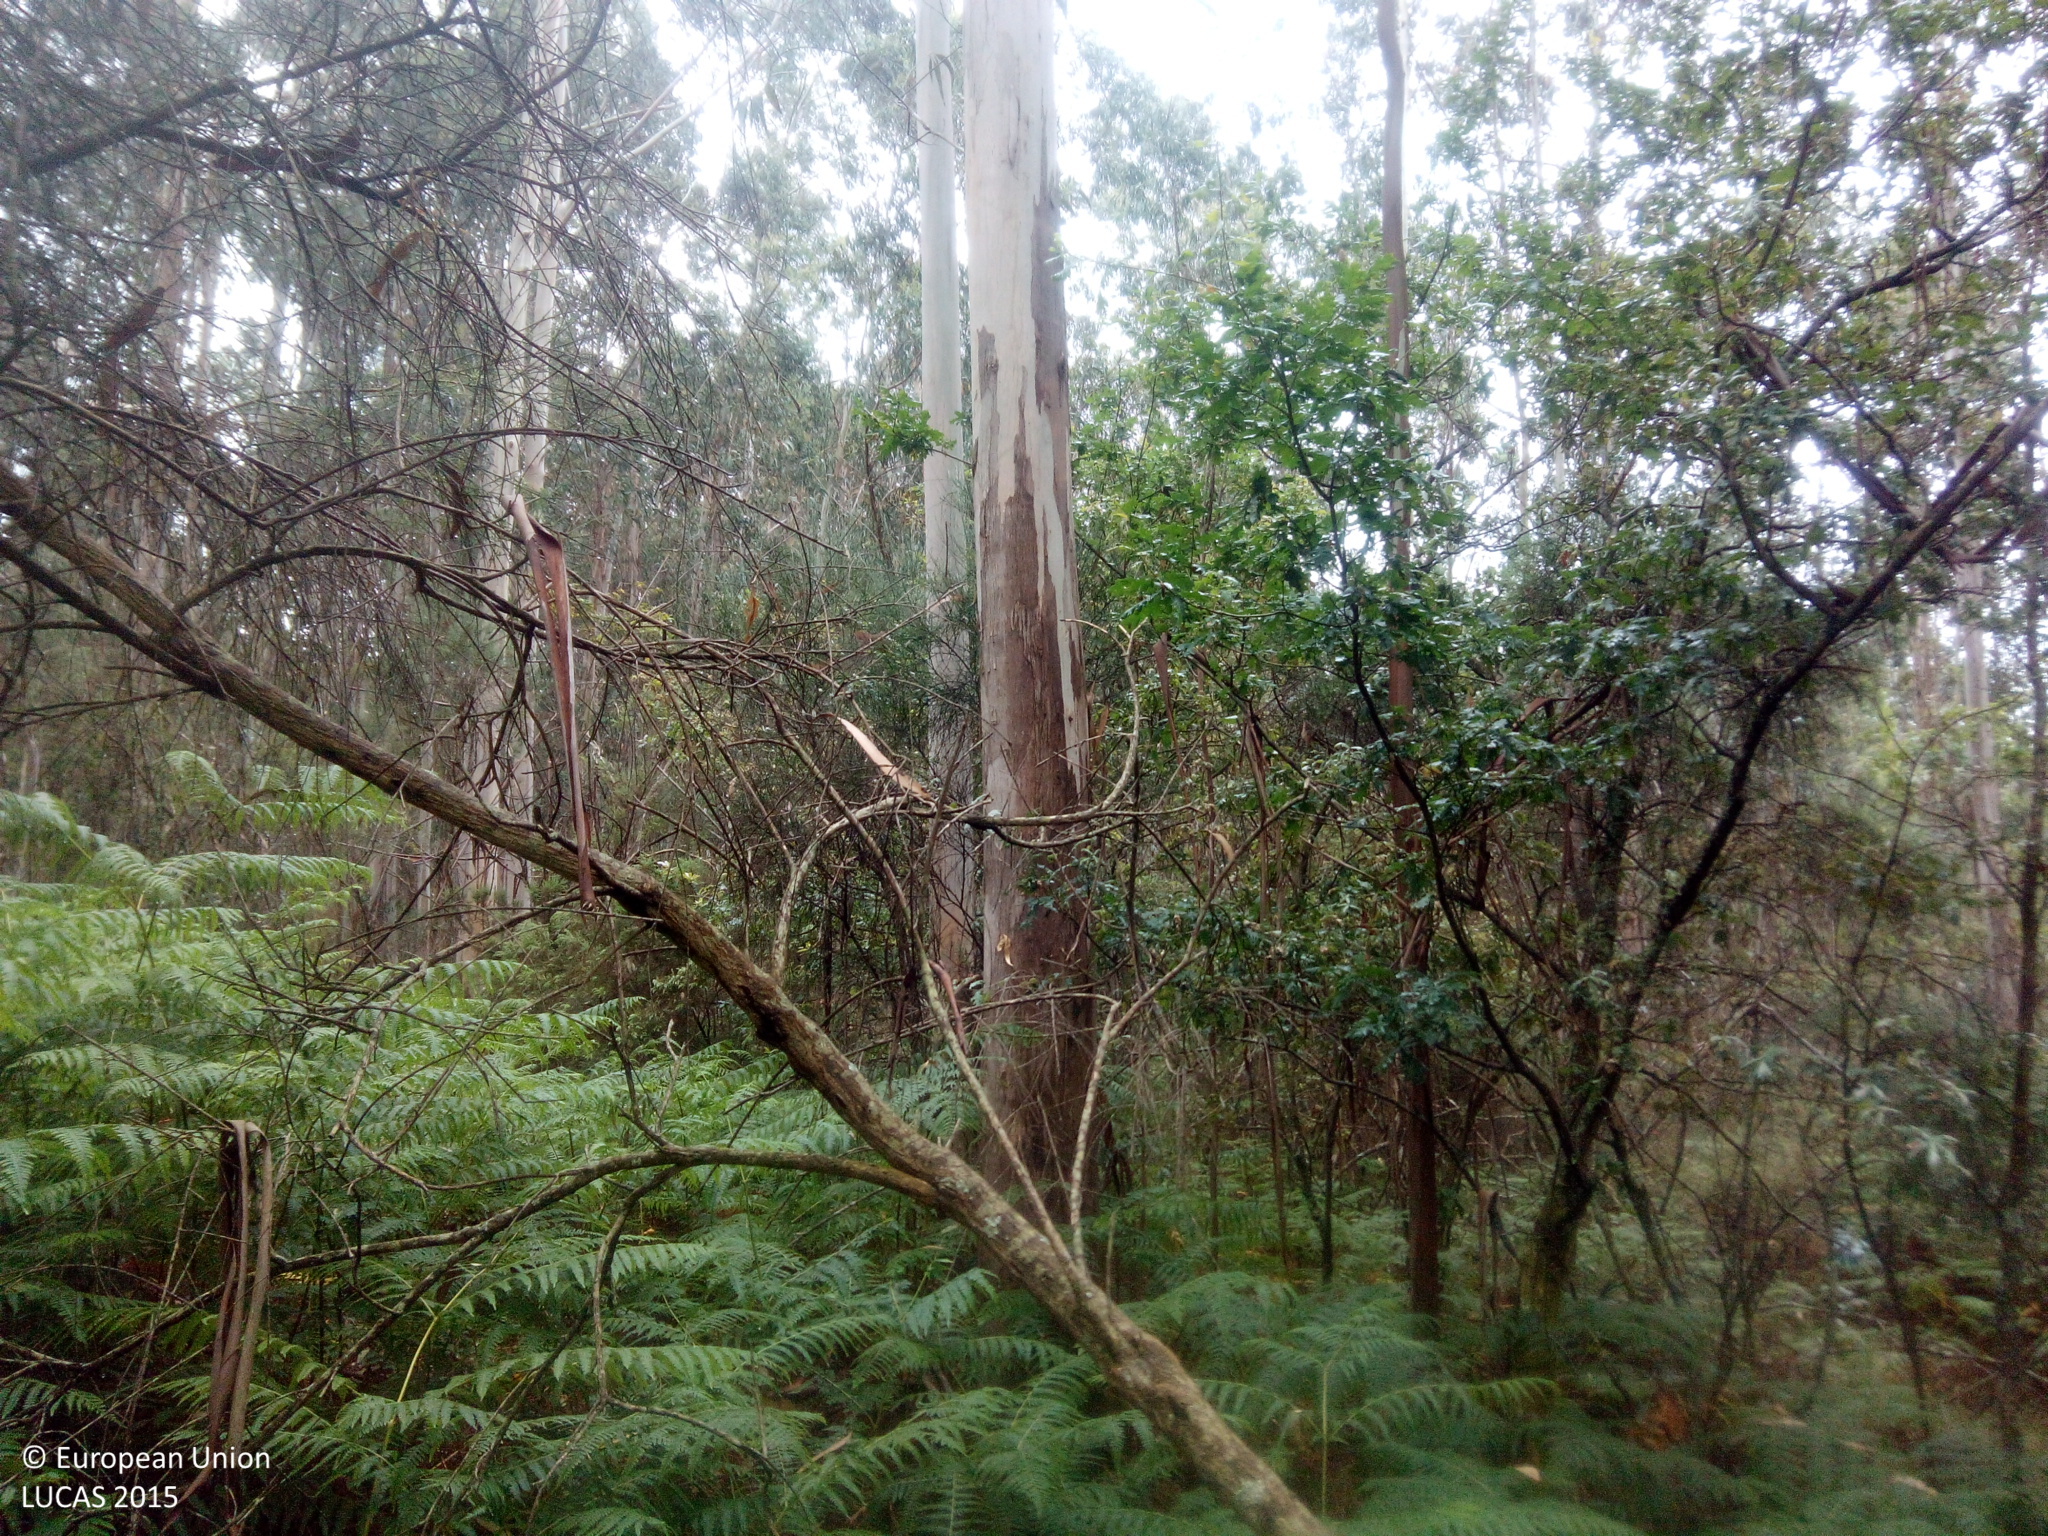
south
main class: Woodland
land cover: Broadleaved woodland
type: exotic forest
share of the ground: > 75 %
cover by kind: broadleaved forest trees 100 %
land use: Forestry
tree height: > 5 m
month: July
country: ES
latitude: 42.2742
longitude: -8.3382
